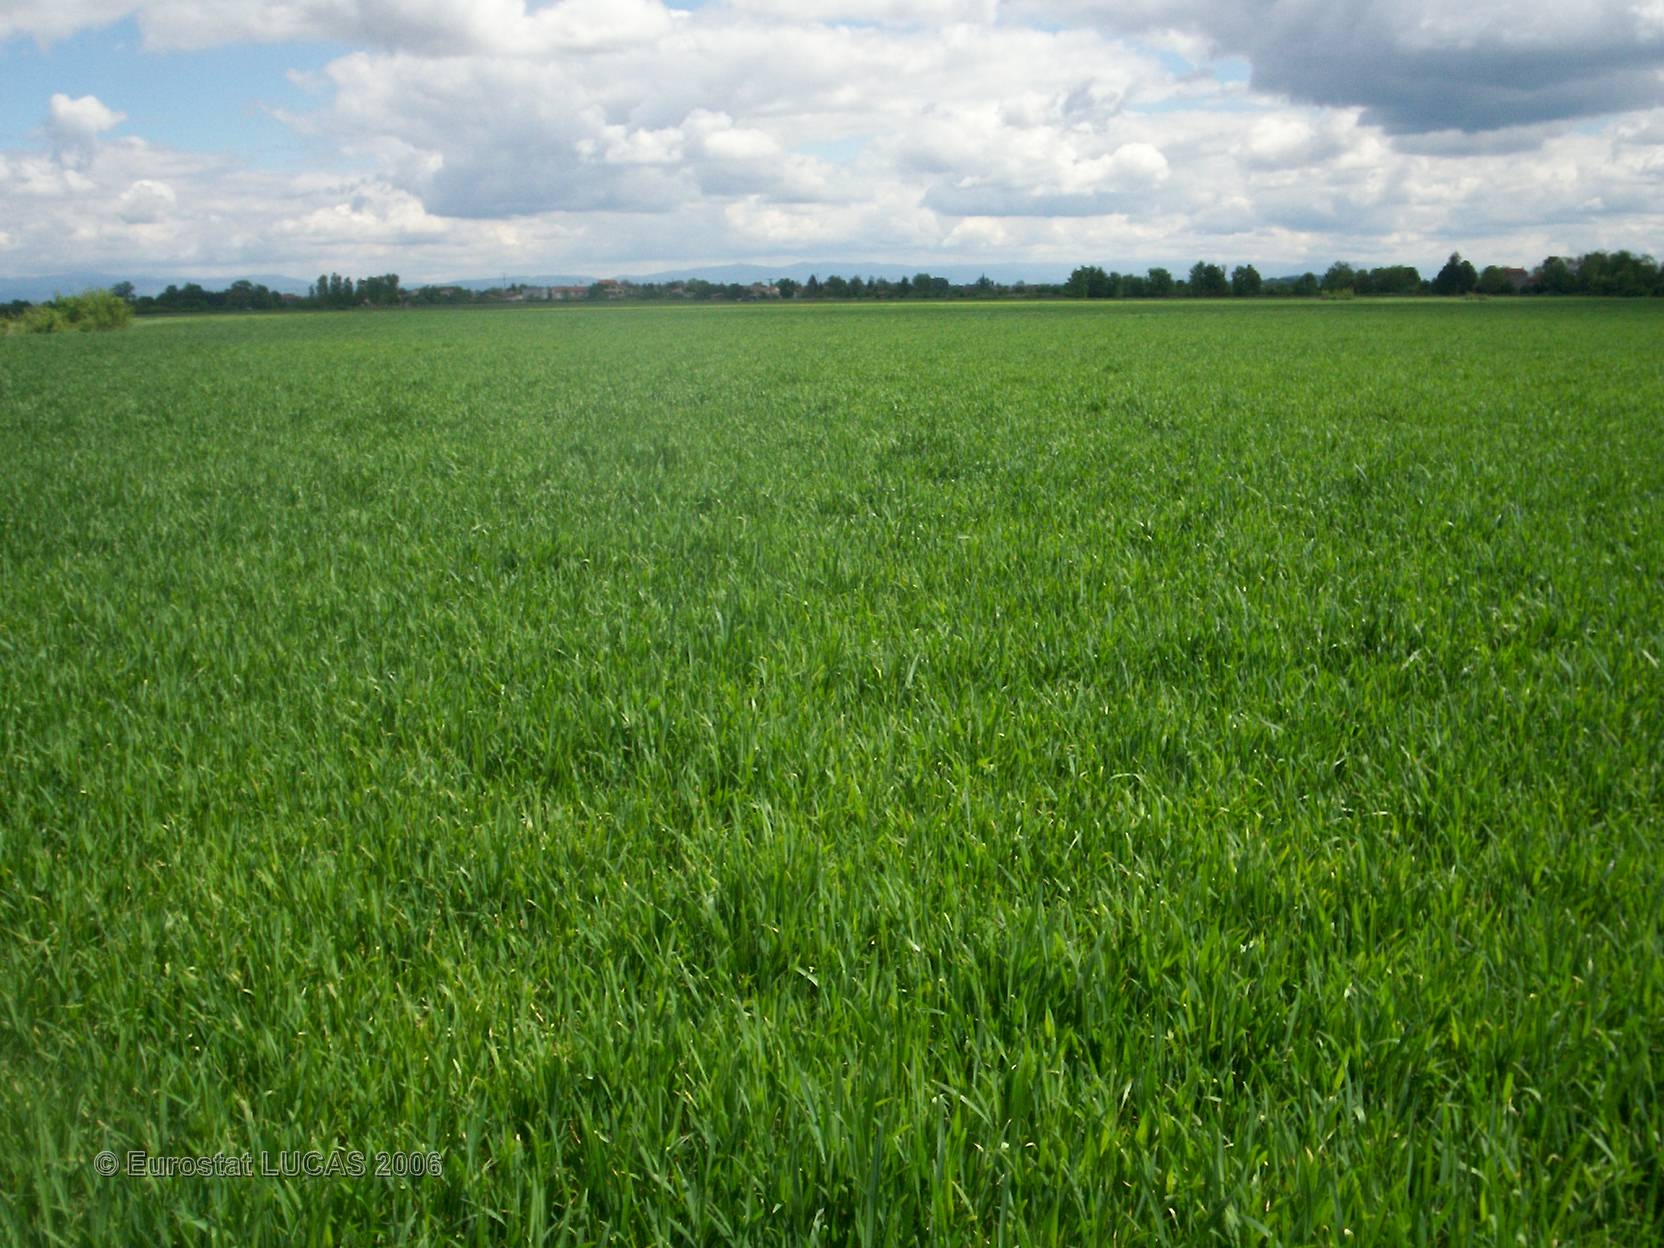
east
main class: Cropland
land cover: Triticale
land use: Agriculture (excluding fallow land and kitchen gardens)
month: May
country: FR
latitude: 45.8448
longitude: 3.1882
